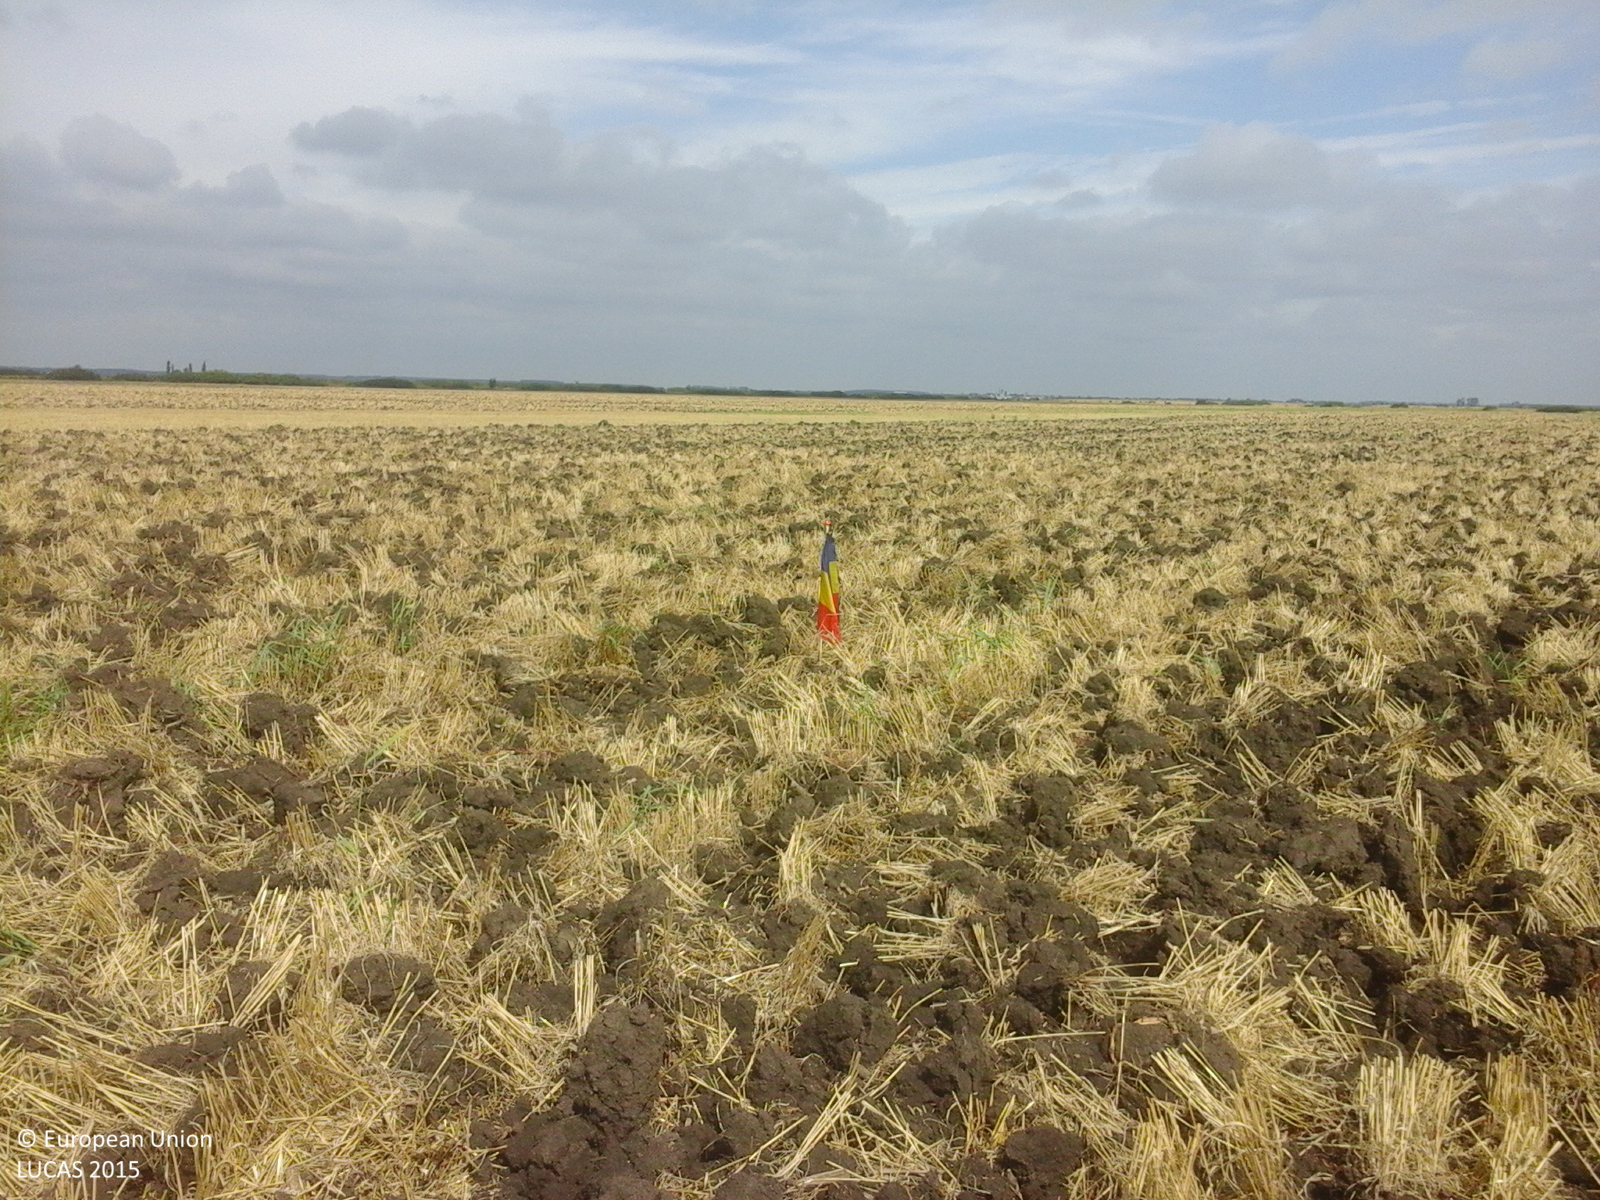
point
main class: Cropland
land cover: Common wheat
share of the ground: 10 - 25 %
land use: Agriculture (excluding fallow land and kitchen gardens)
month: August
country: RO
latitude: 45.3175
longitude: 21.2670
